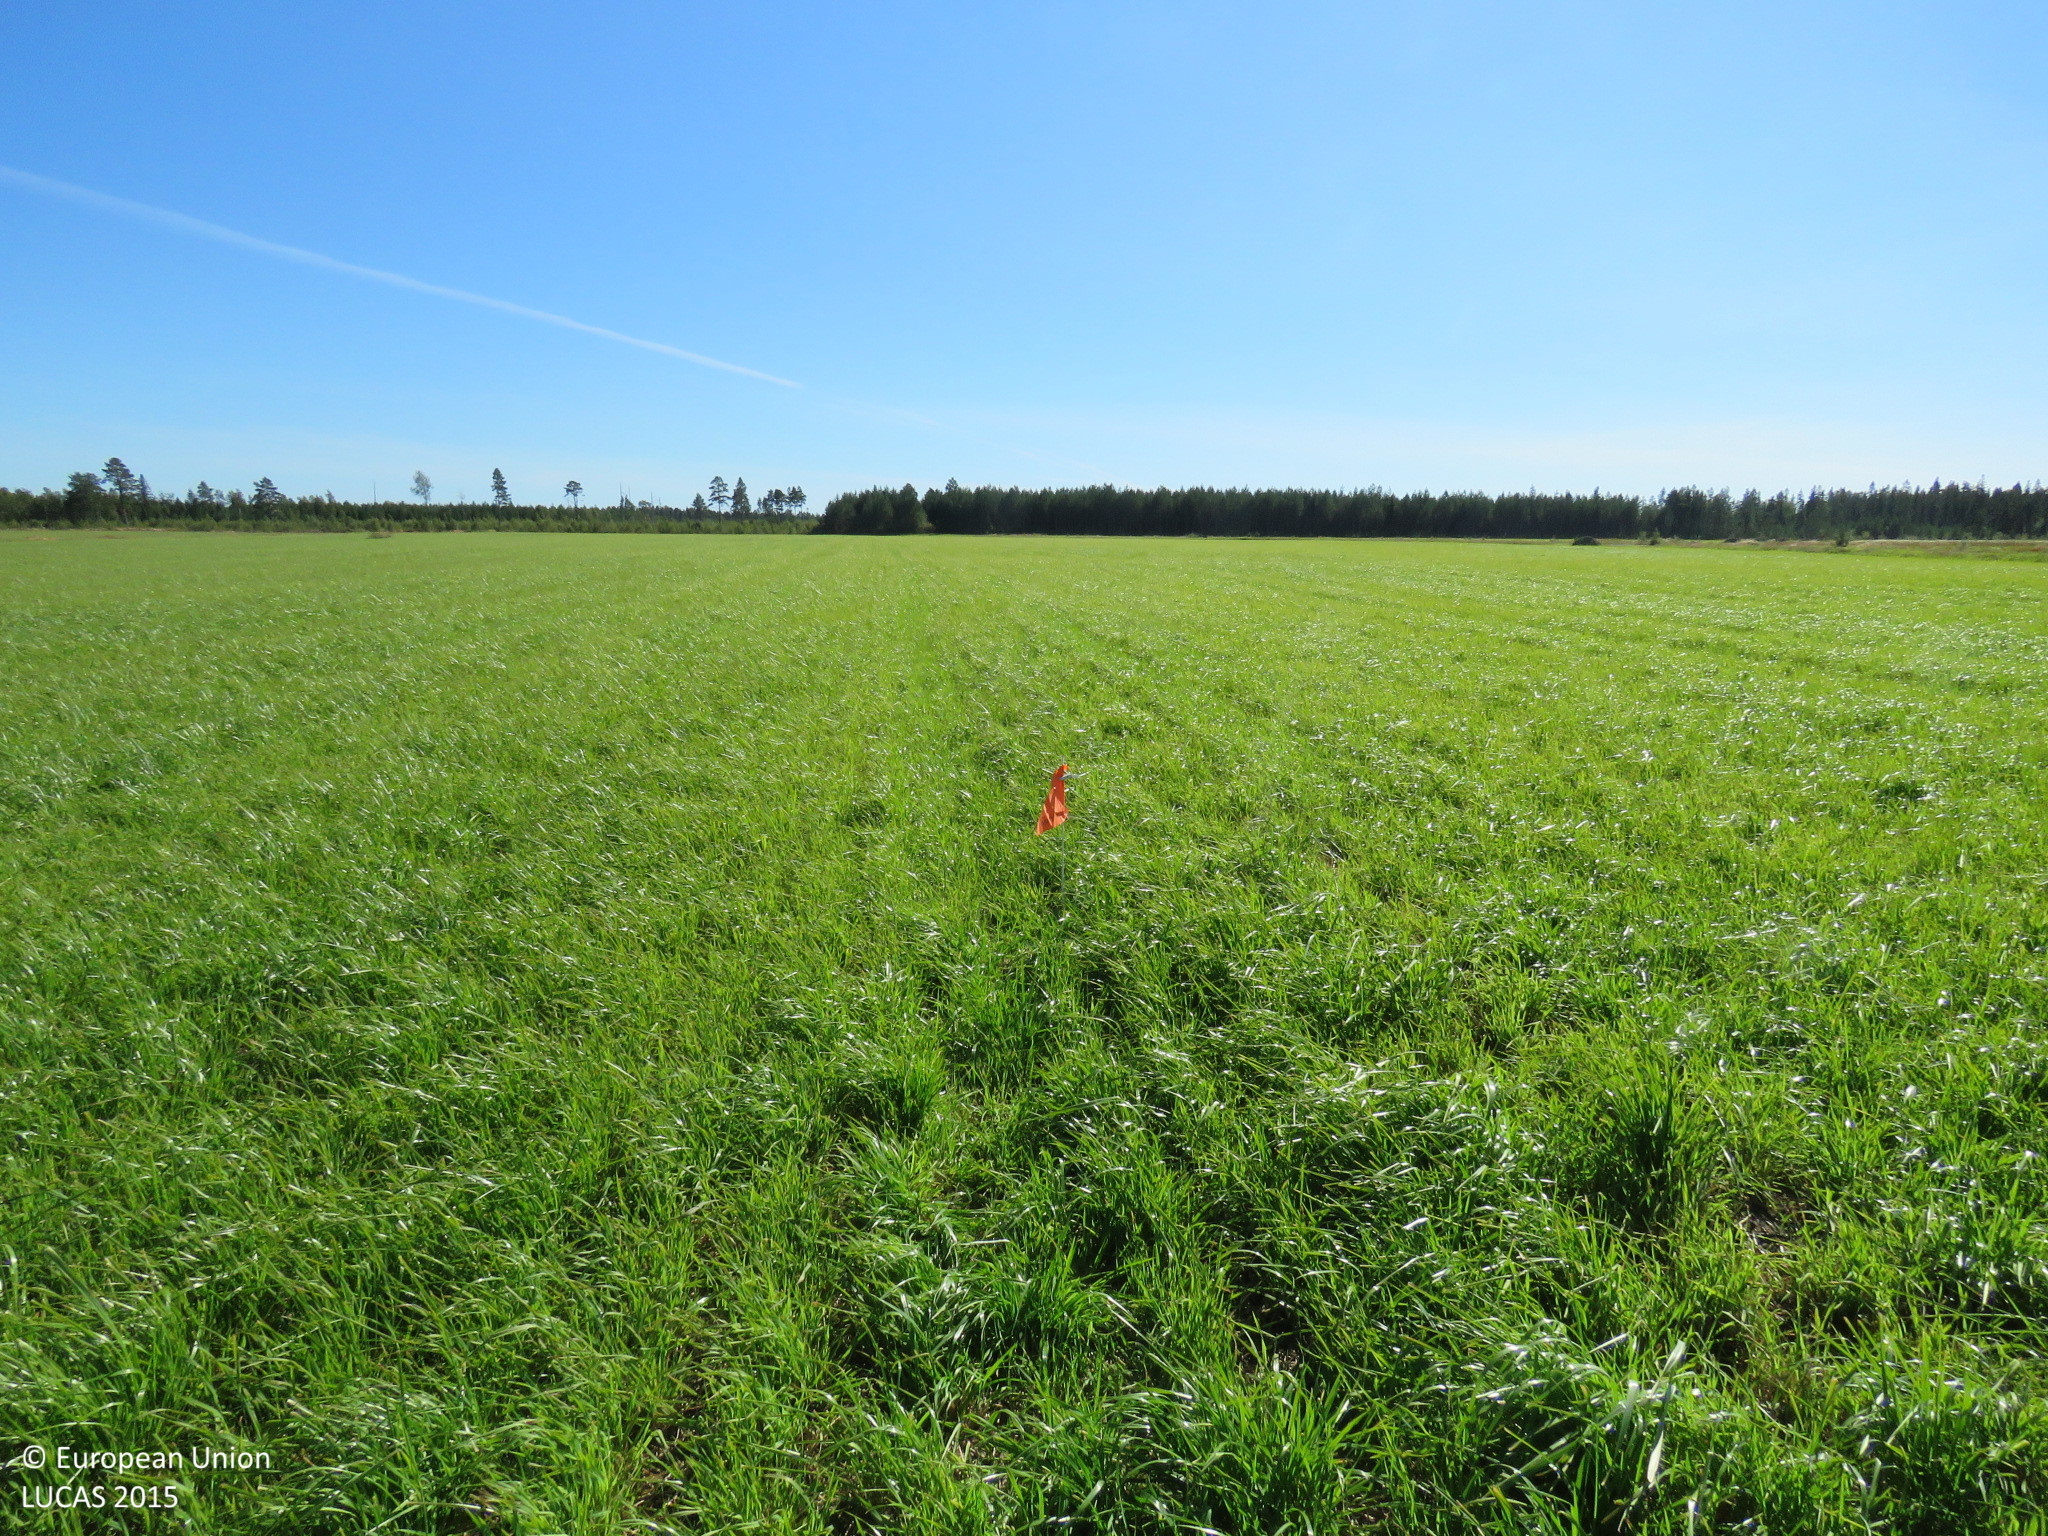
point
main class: Cropland
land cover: Temporary grasslands
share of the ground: > 75 %
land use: Agriculture (excluding fallow land and kitchen gardens)
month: August
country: FI
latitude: 65.0255
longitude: 24.8219
